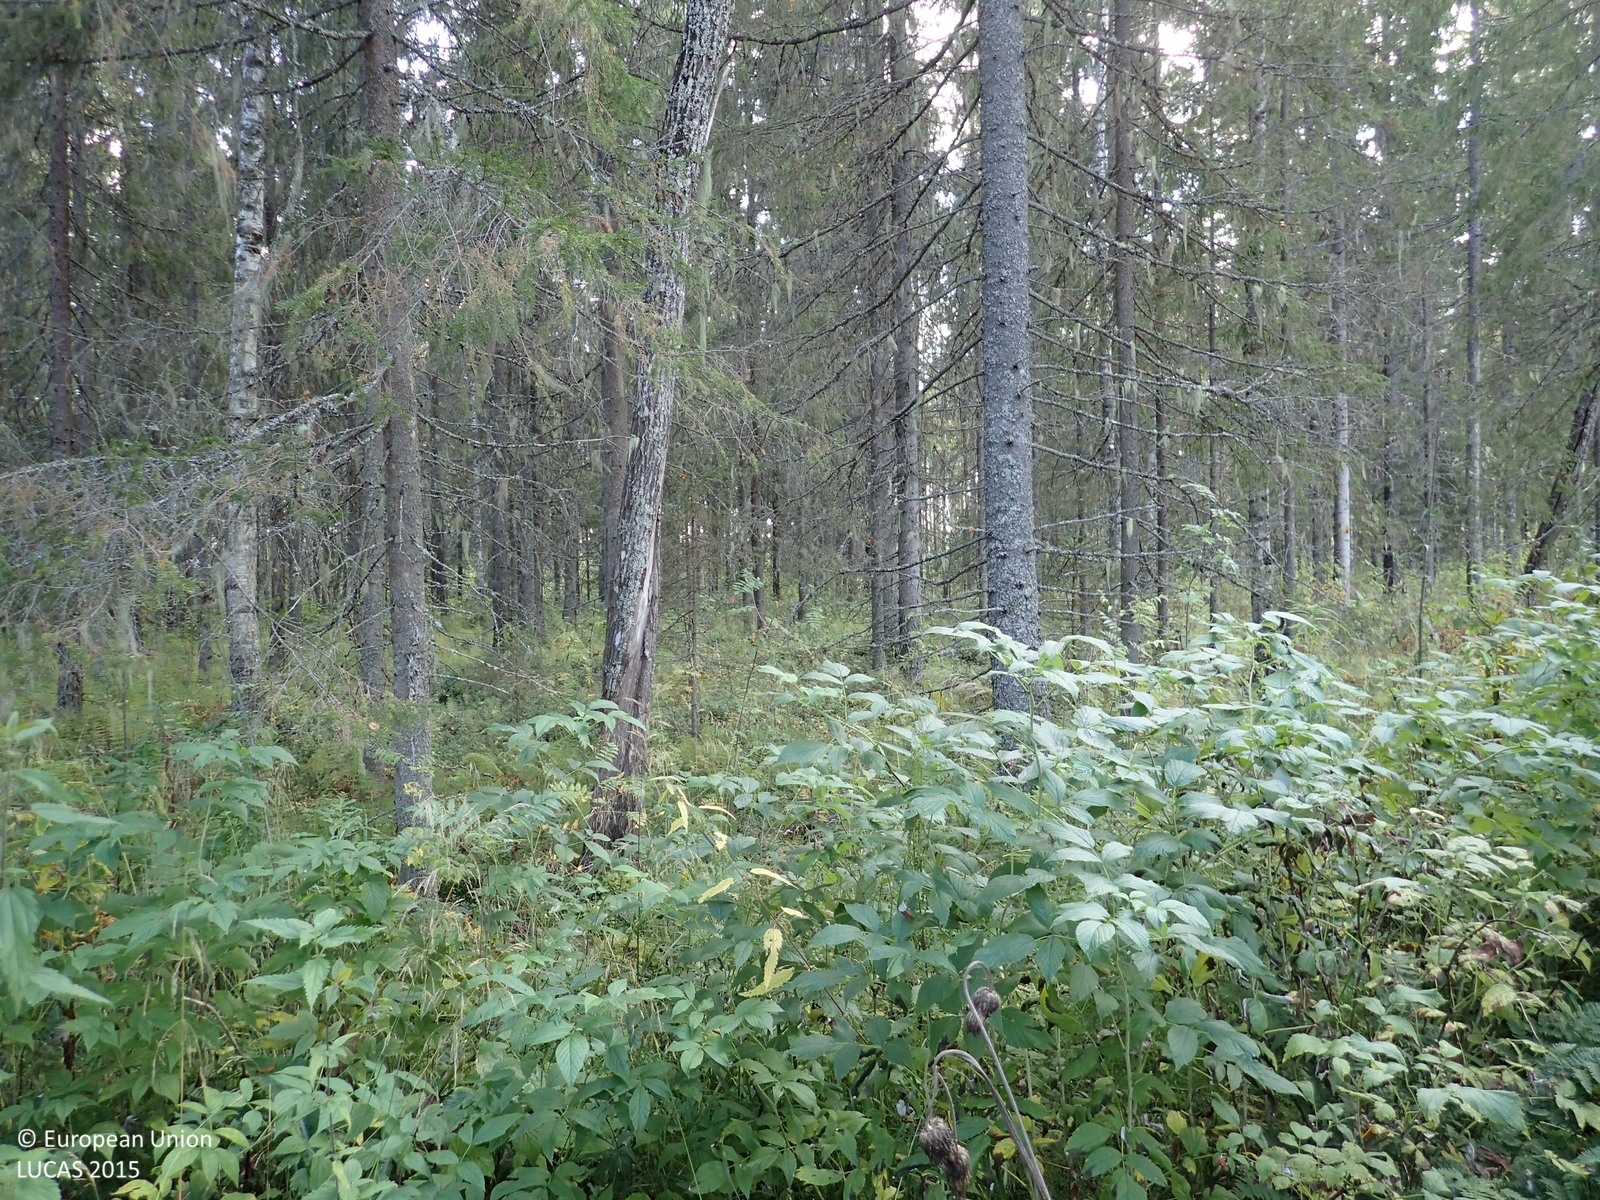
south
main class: Woodland
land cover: Spruce dominated coniferous woodland
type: boreal forest
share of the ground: > 75 %
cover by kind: coniferous forest trees 70 %, herbaceous plants 20 %, broadleaved forest trees 5 %, shrubs 5 %
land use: Forestry
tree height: > 5 m
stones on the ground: < 10 %
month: September
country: FI
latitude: 63.1859
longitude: 25.5042
